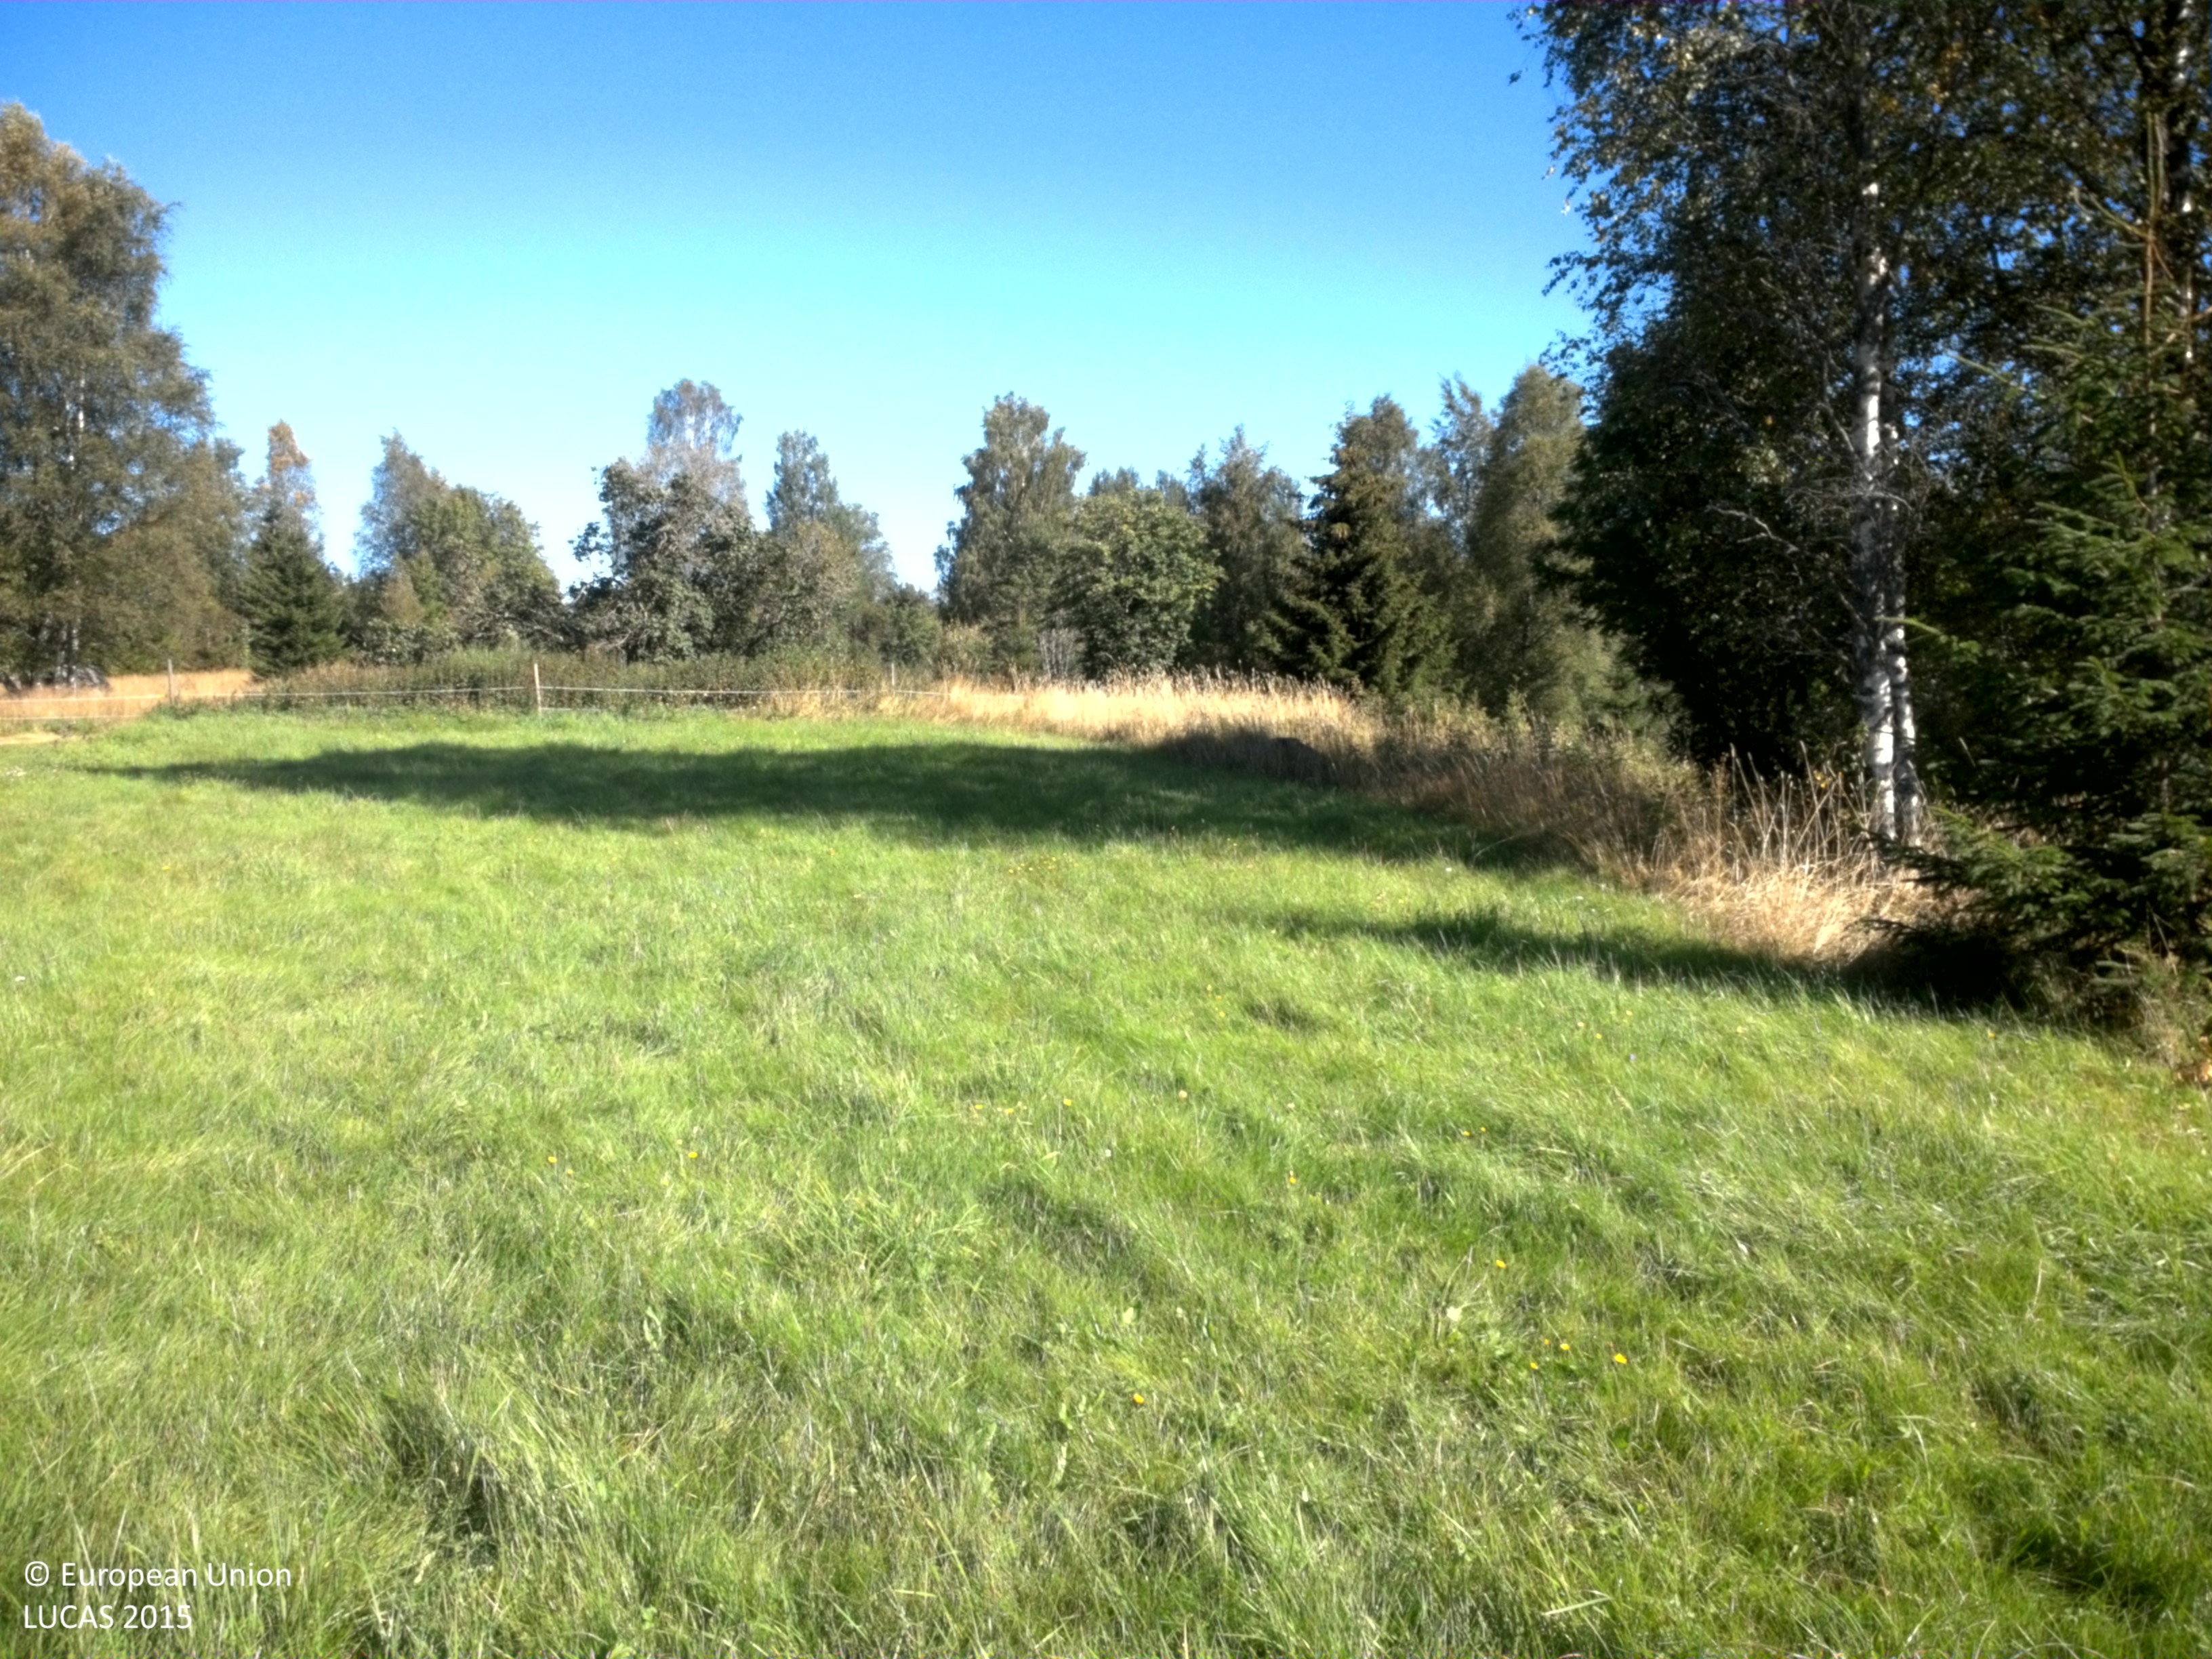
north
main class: Grassland
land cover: Grassland without tree/shrub cover
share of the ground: > 75 %
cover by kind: herbaceous plants 100 %
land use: Agriculture (excluding fallow land and kitchen gardens)
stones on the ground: < 10 %
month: August
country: SE
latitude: 59.8493
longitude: 14.1491
